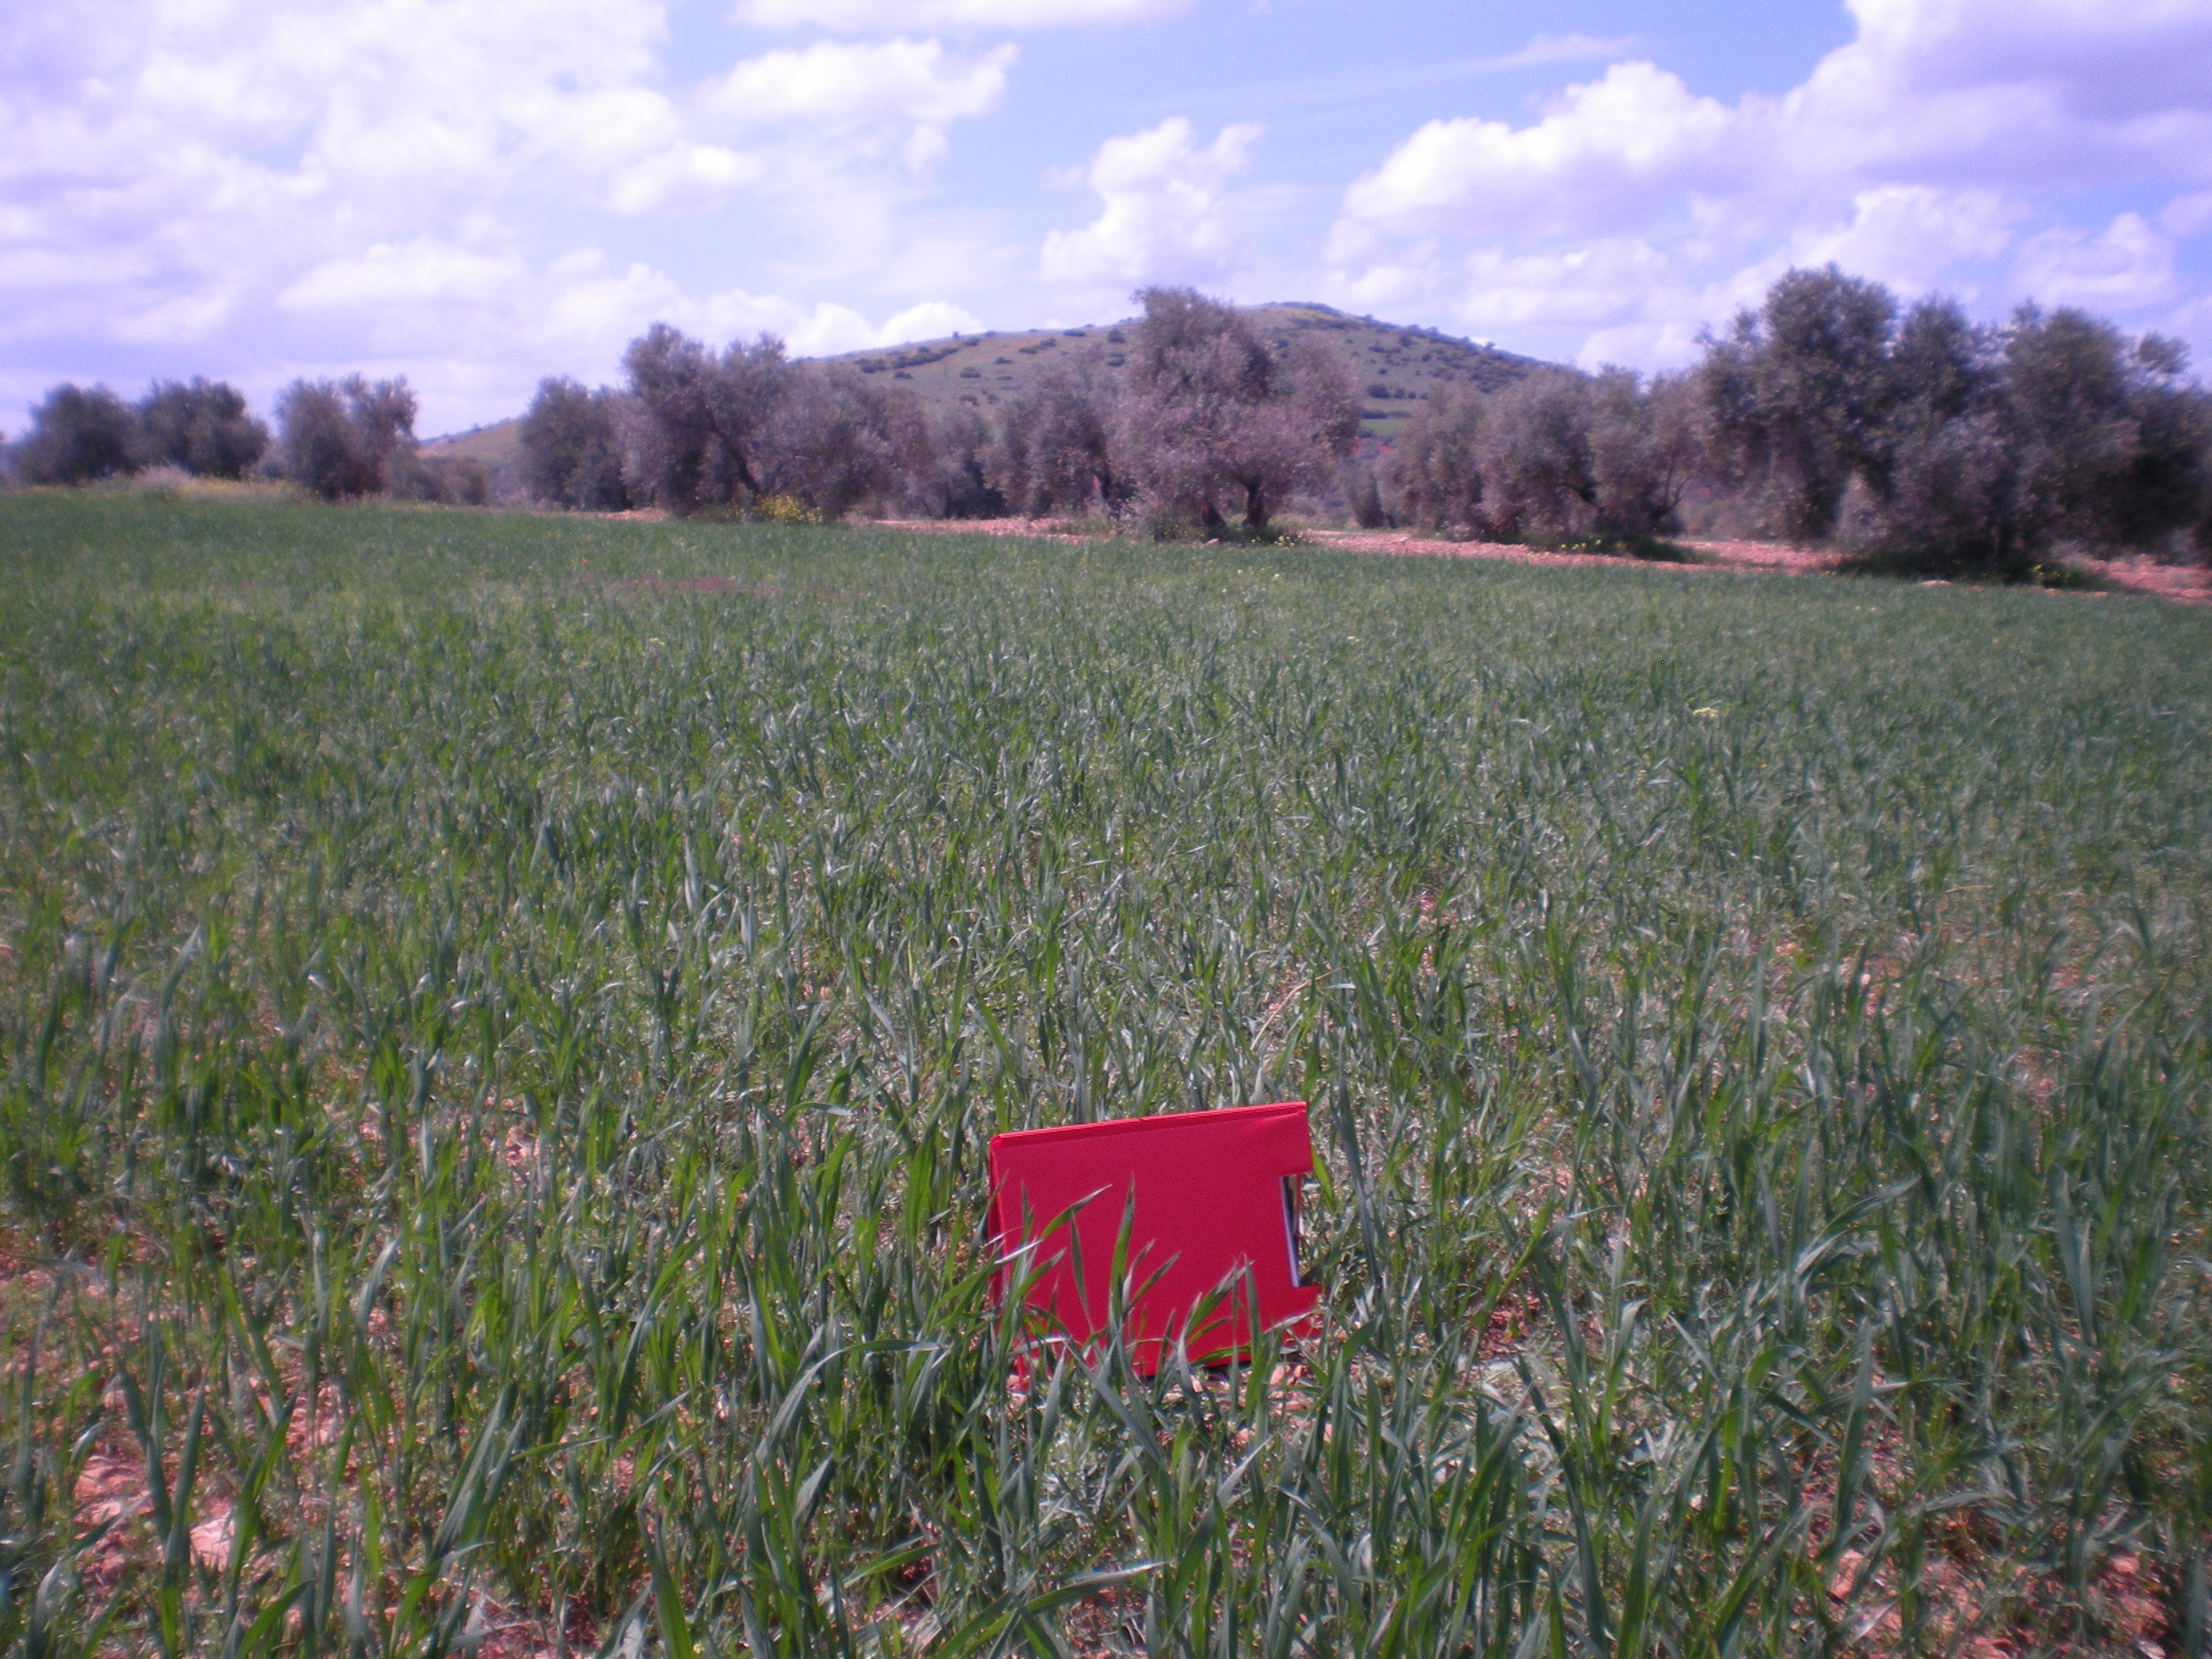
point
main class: Cropland
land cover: Barley
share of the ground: 50 - 75 %
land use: Agriculture (excluding fallow land and kitchen gardens)
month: April
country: ES
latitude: 38.6887
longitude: -3.4965
